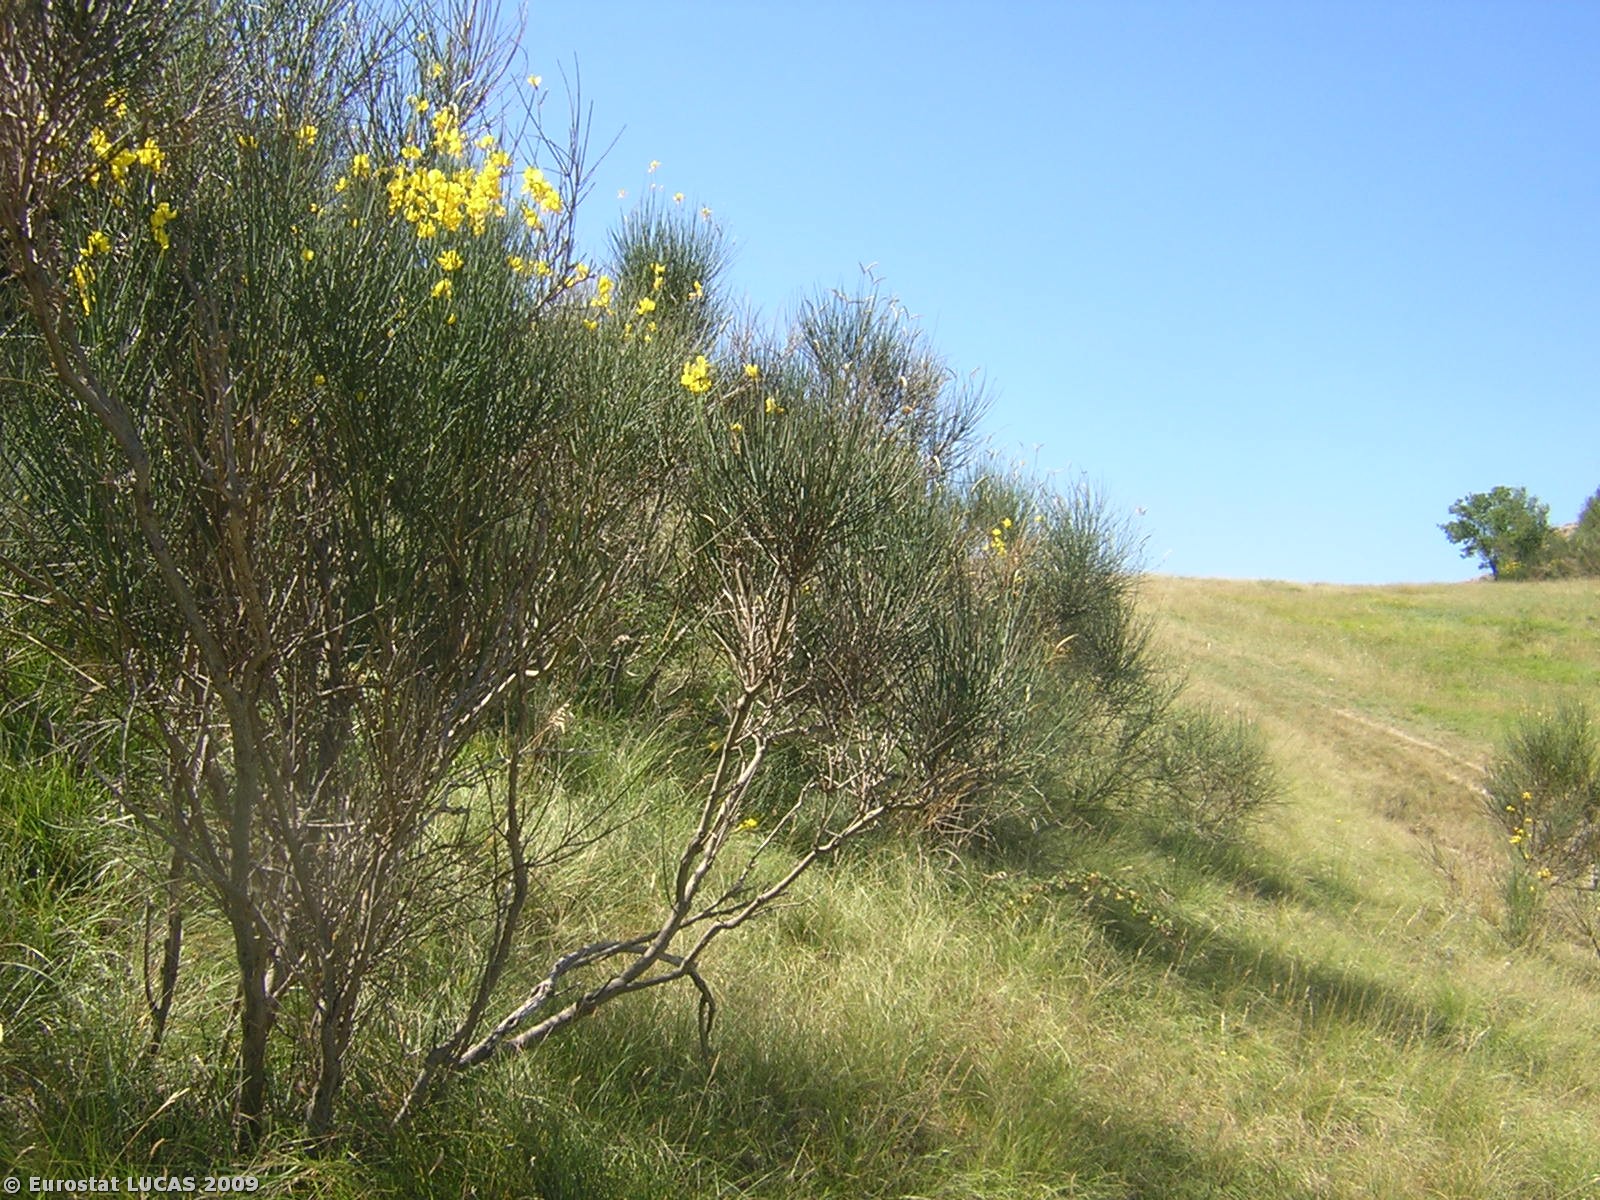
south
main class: Shrubland
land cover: Shrubland with sparse tree cover
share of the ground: > 75 %
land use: Unused
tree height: > 5 m
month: July
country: IT
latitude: 43.1551
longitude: 12.8819
